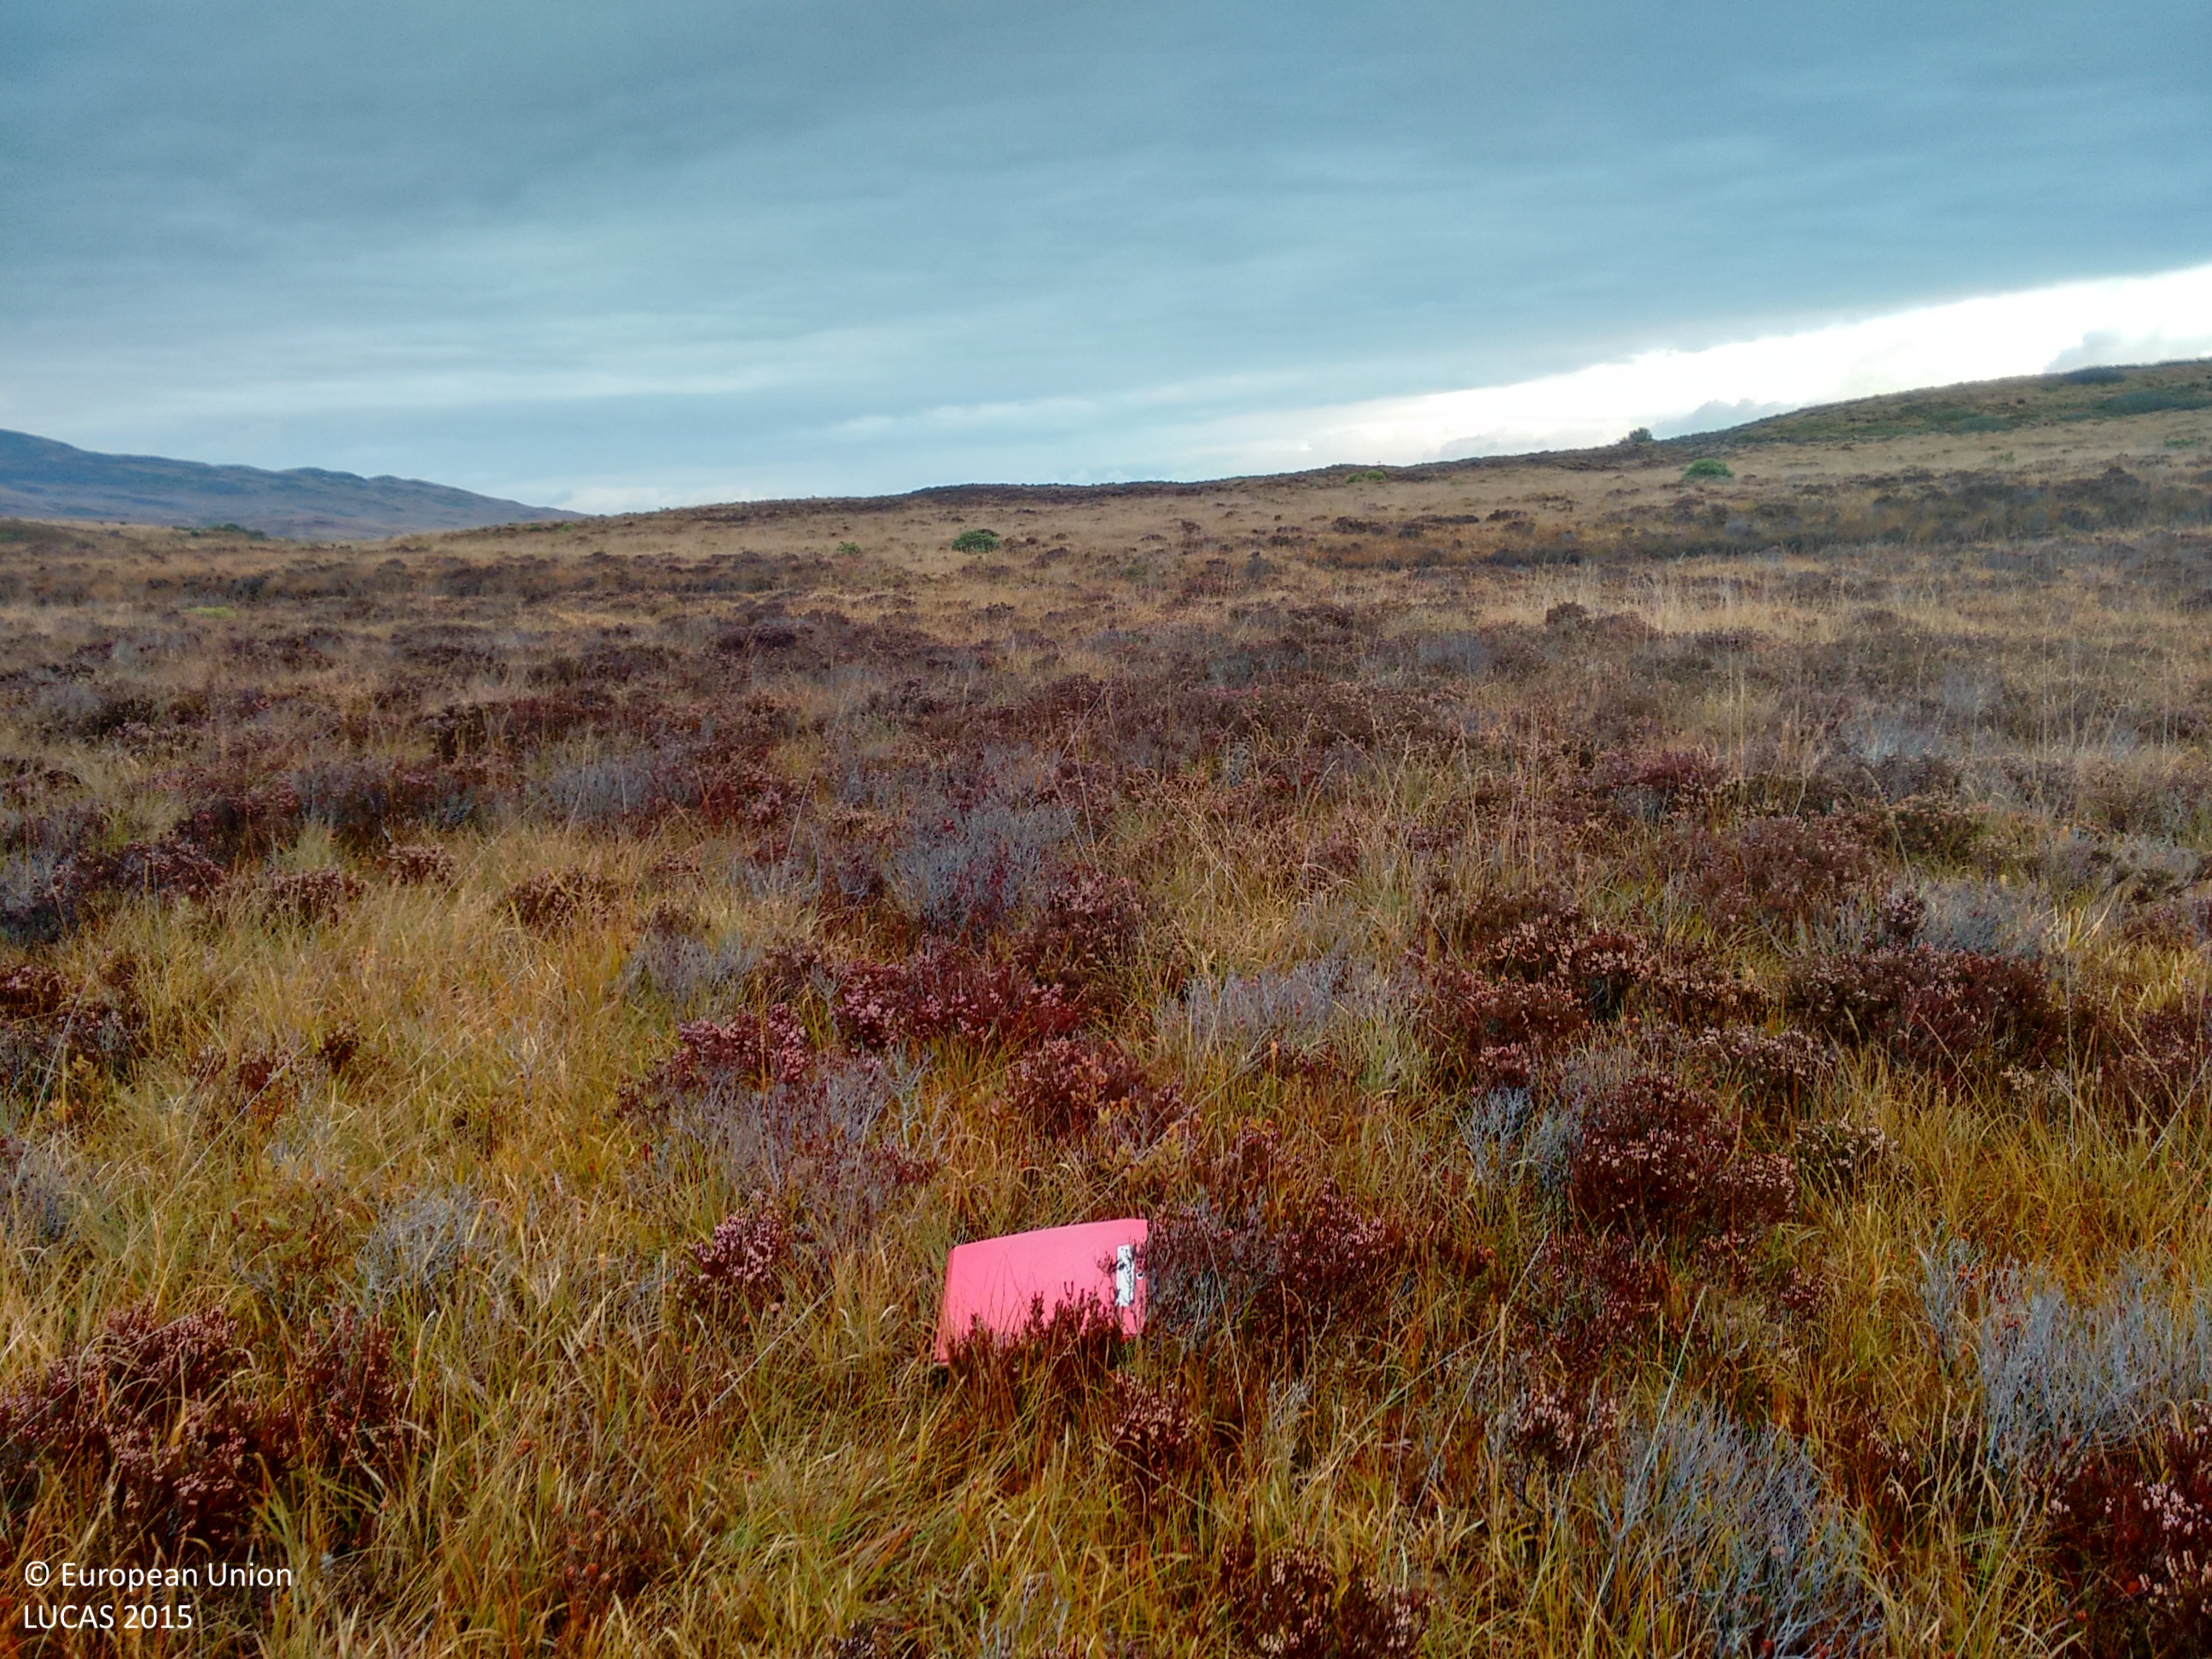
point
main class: Shrubland
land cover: Shrubland without tree cover
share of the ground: > 75 %
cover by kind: shrubs 80 %, herbaceous plants 10 %, lichens and mosses 10 %
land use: Agriculture (excluding fallow land and kitchen gardens)
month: October
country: GB
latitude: 55.8729
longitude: -6.1385
